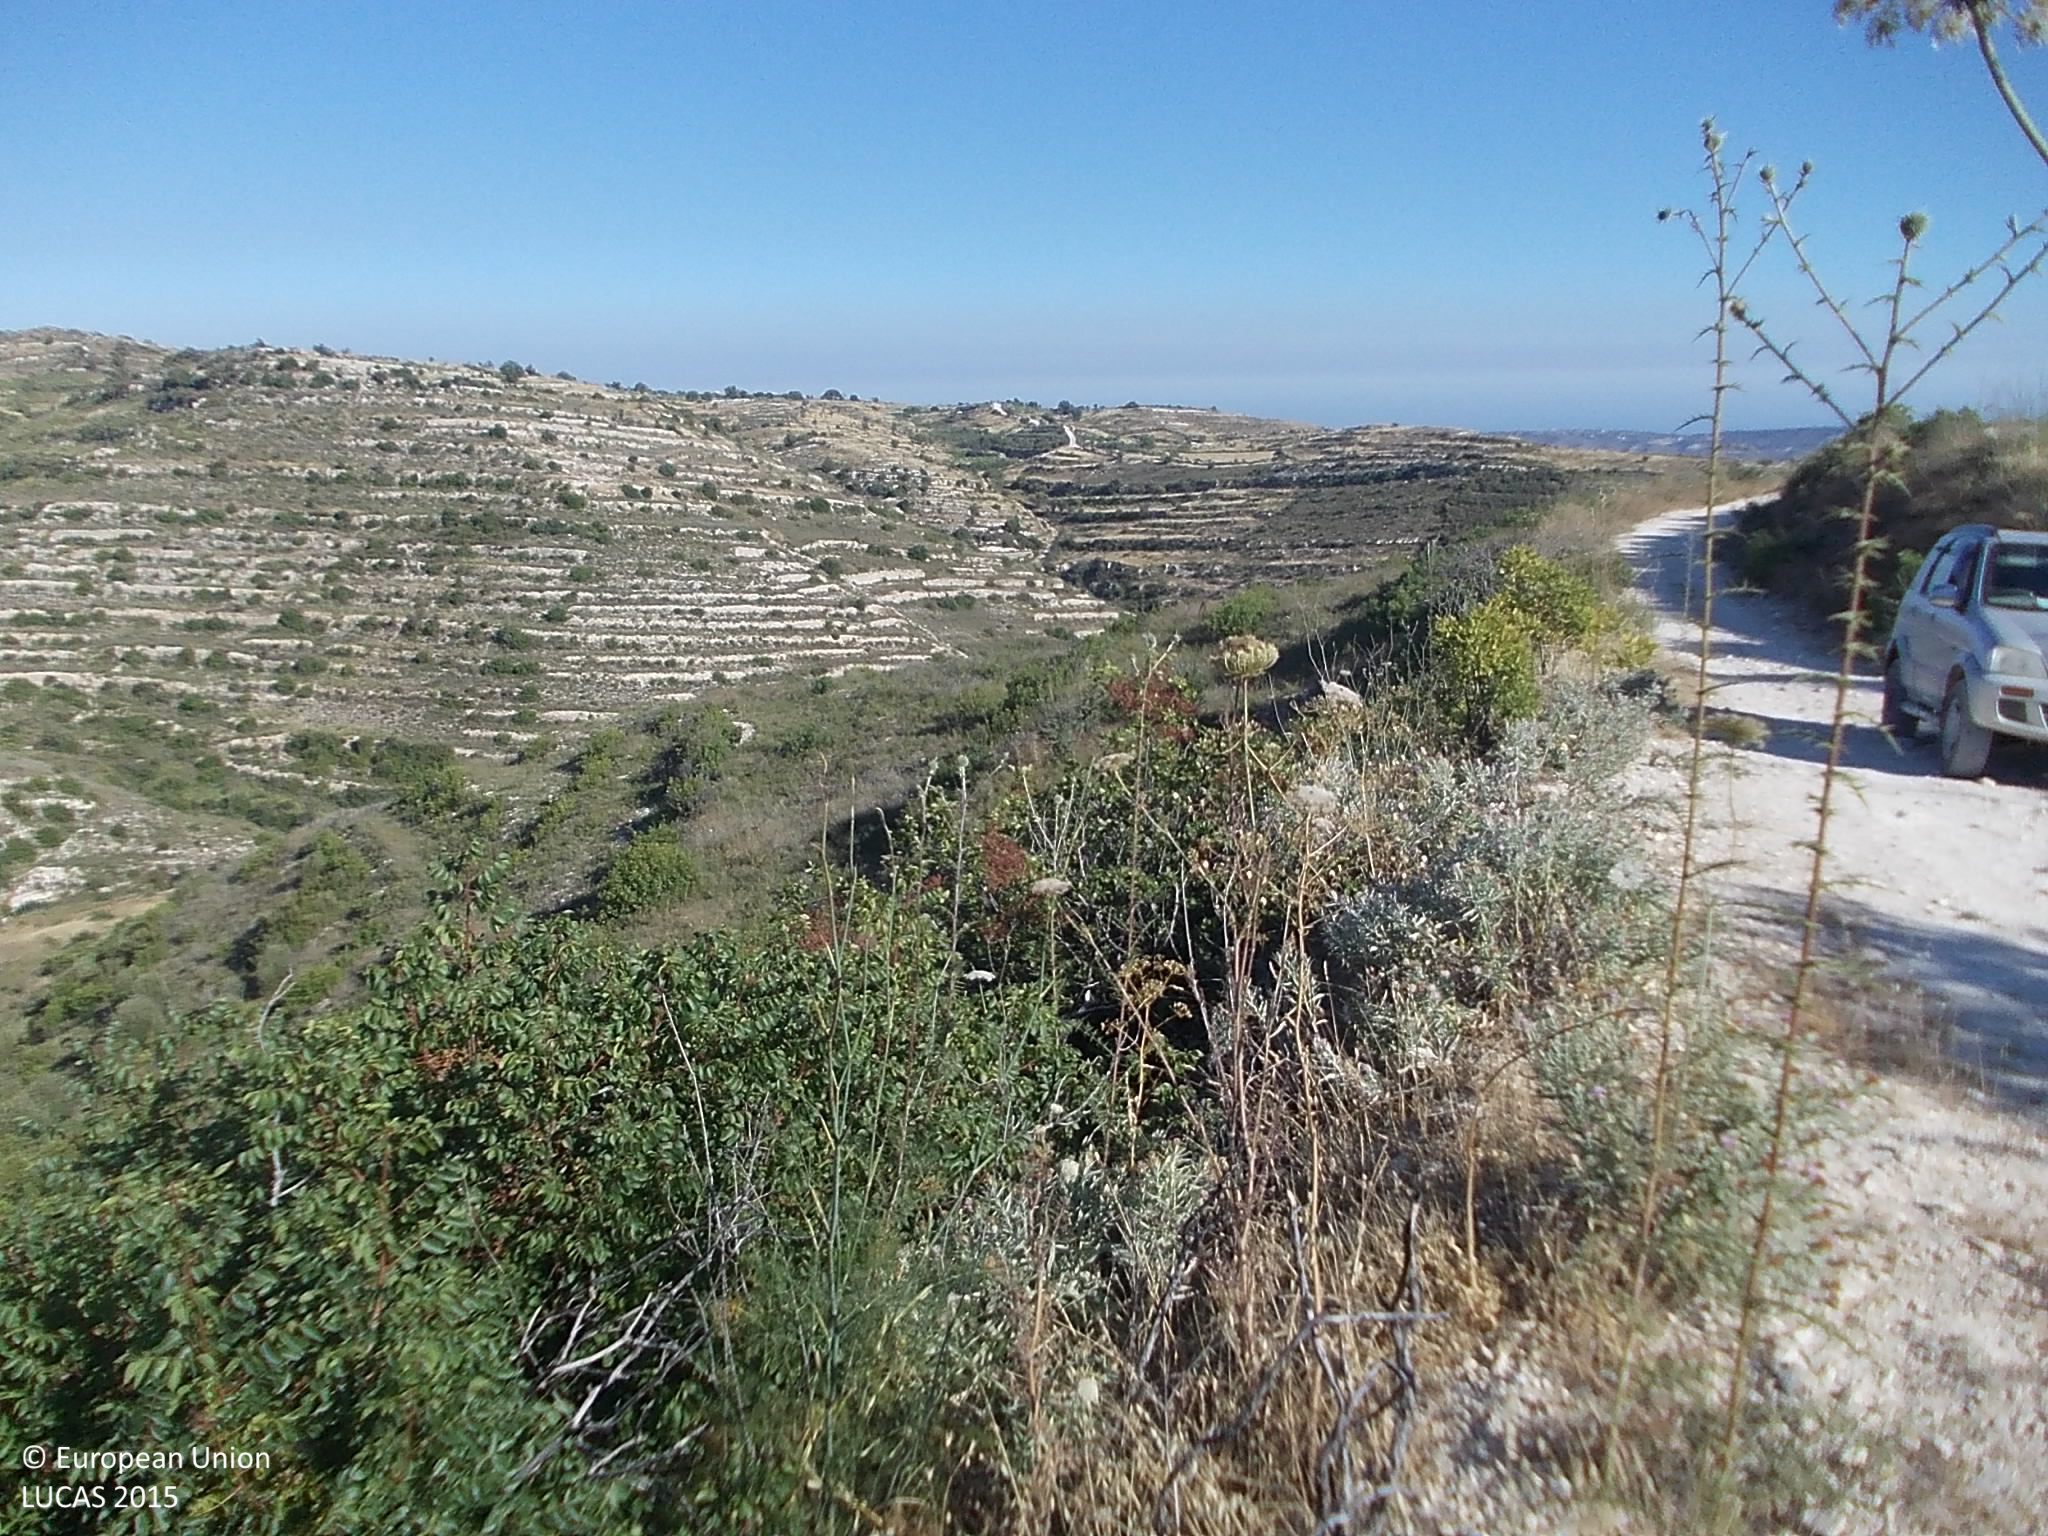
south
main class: Shrubland
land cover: Shrubland without tree cover
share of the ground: 50 - 75 %
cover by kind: shrubs 65 %, unconsolidated bare surface 20 %, herbaceous plants 15 %
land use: Semi-natural and natural areas not in use
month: July
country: CY
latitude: 34.8372
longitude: 32.8304
